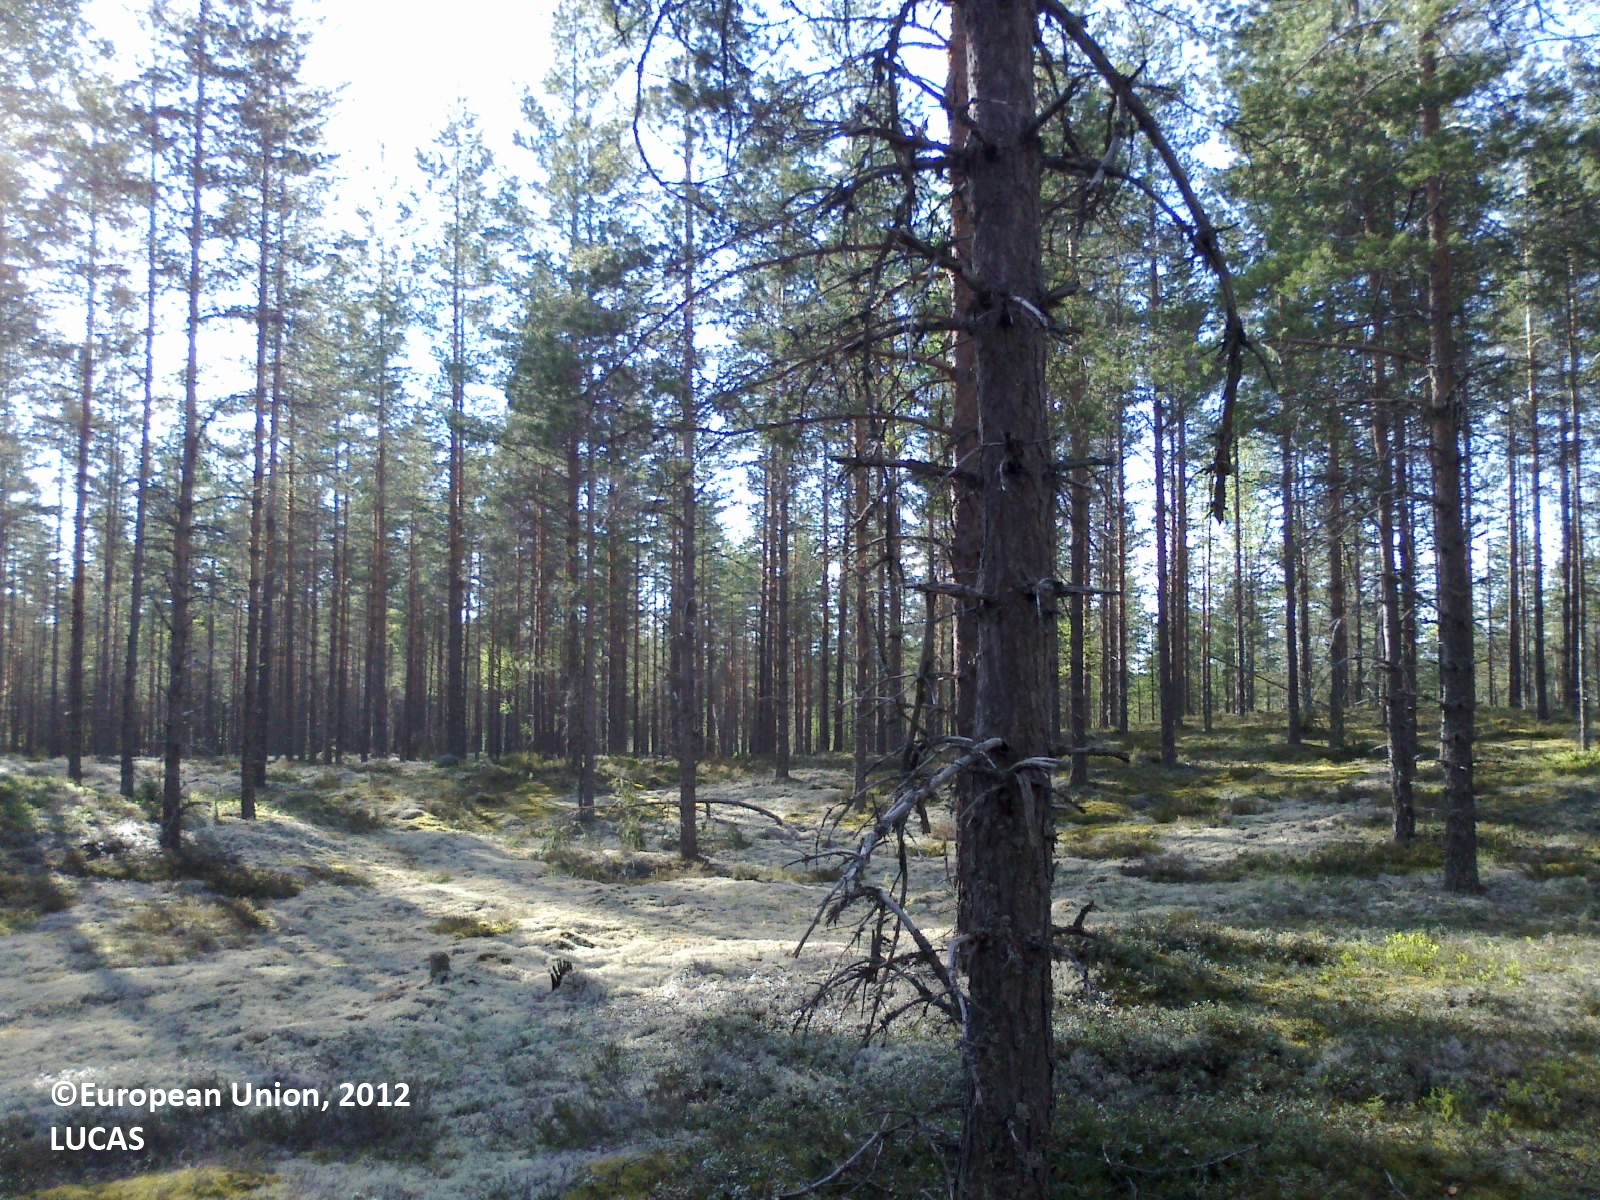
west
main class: Woodland
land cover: Pine dominated coniferous woodland
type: boreal forest
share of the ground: 50 - 75 %
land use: Forestry
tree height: > 5 m
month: May
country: FI
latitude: 62.4364
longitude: 25.4336
